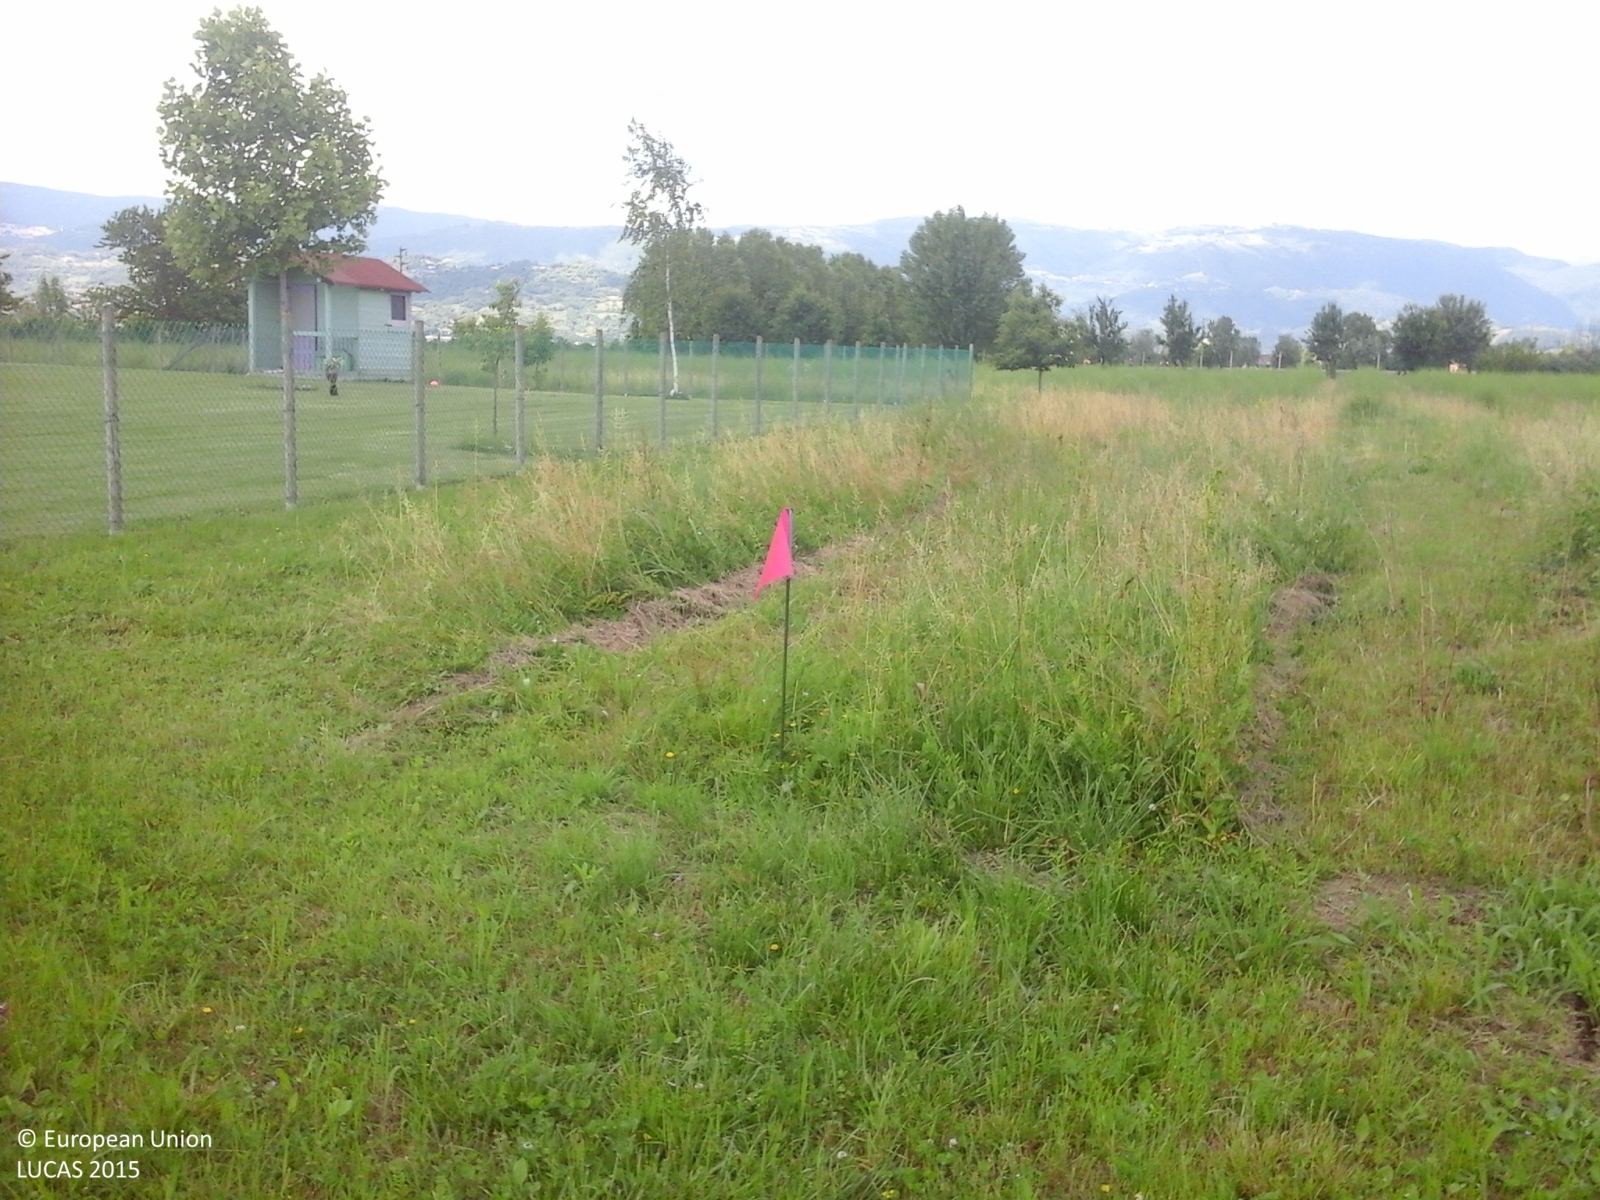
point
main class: Cropland
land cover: Other fresh vegetables
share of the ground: > 75 %
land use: Agriculture (excluding fallow land and kitchen gardens)
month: May
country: IT
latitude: 45.7077
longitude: 11.6545
